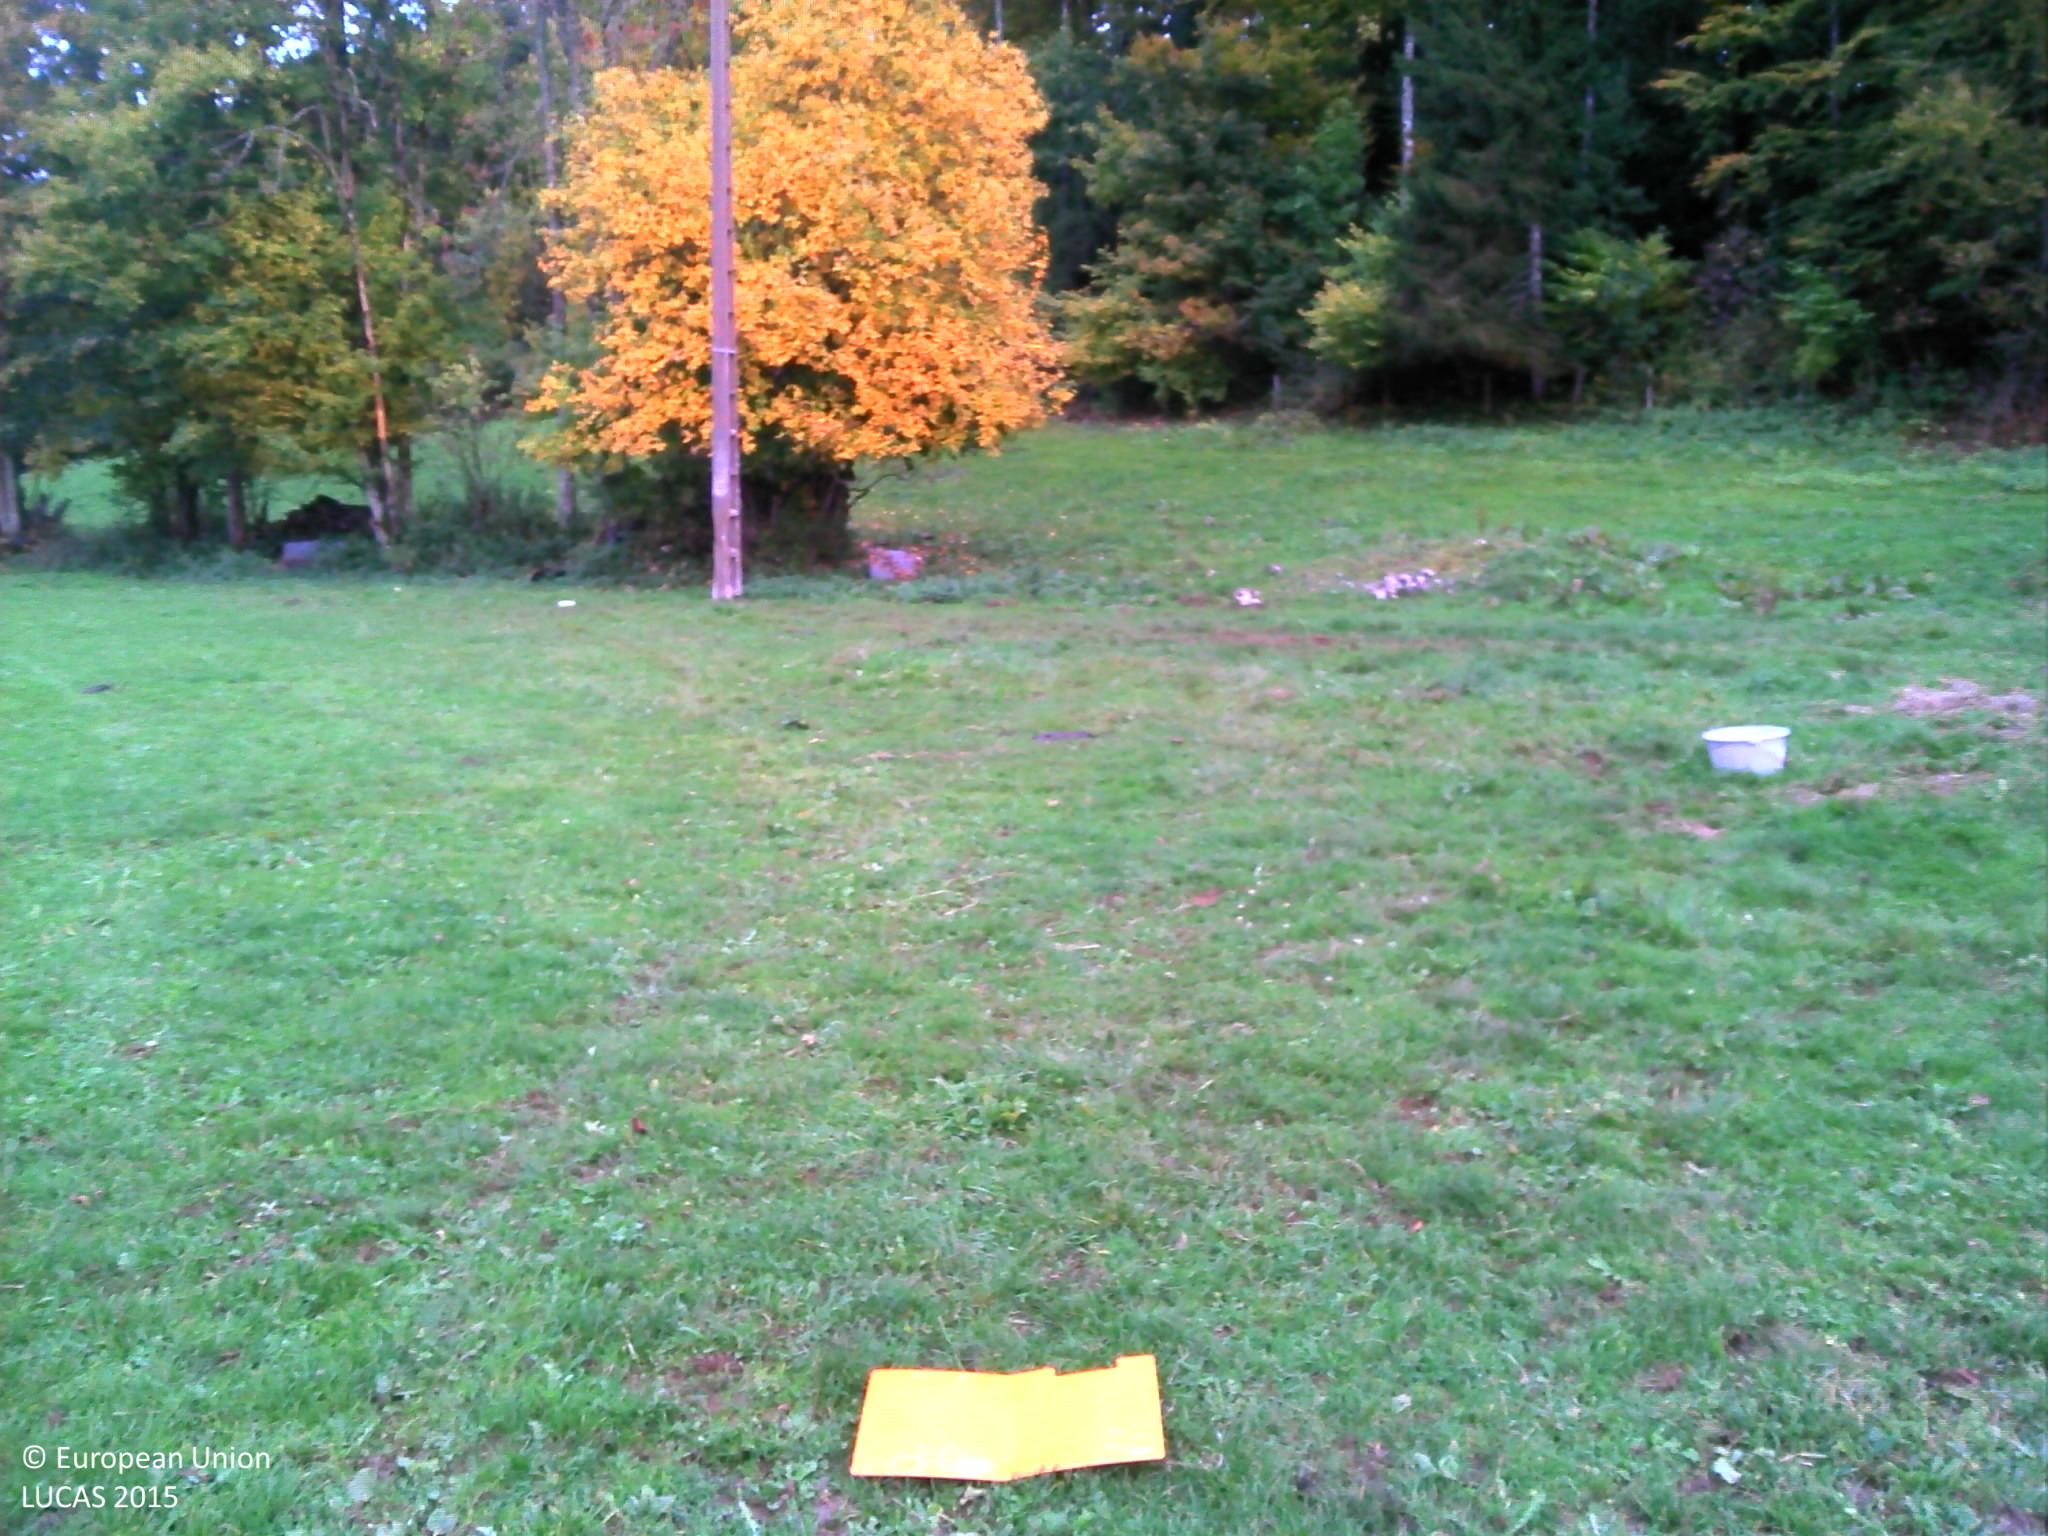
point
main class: Grassland
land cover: Grassland without tree/shrub cover
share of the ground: > 75 %
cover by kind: herbaceous plants 100 %
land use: Agriculture (excluding fallow land and kitchen gardens)
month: October
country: FR
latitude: 46.8296
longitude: 6.3449
